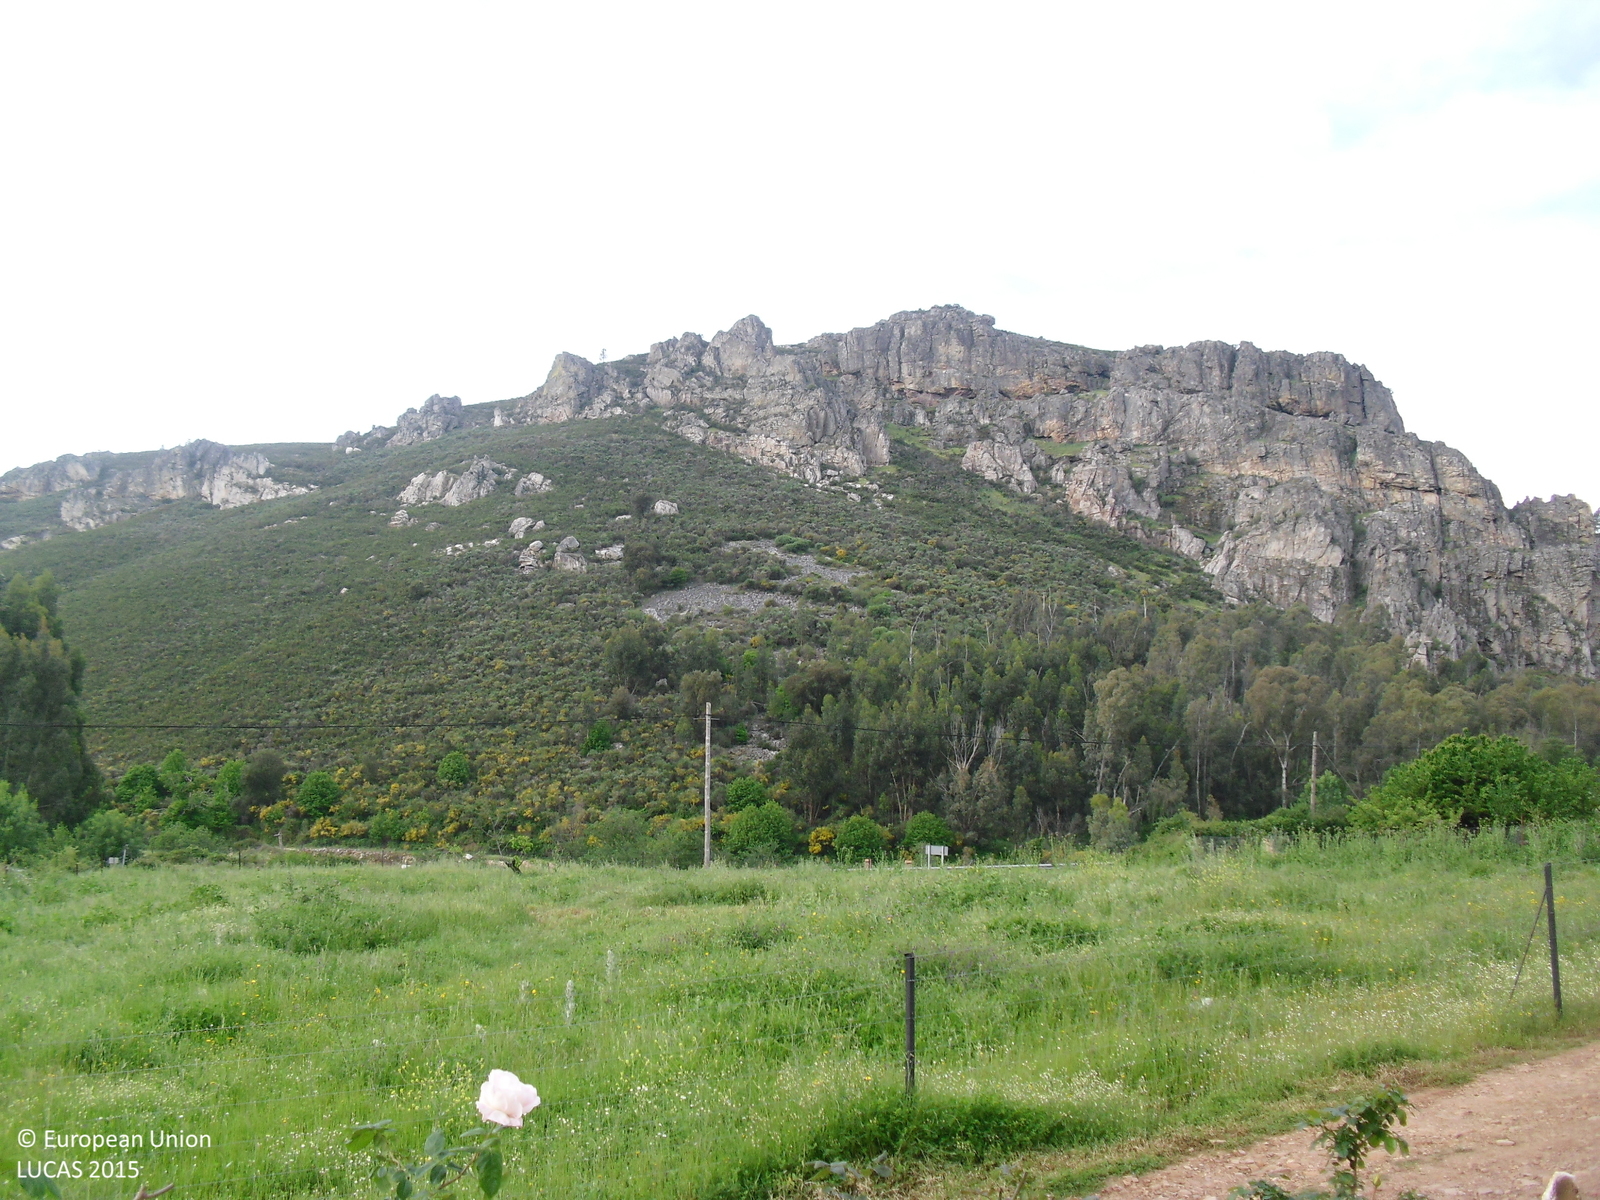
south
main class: Woodland
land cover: Broadleaved woodland
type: thermophilous deciduous forest
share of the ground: 10 - 25 %
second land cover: Grassland without tree/shrub cover
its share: > 75 %
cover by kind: herbaceous plants 80 %, broadleaved forest trees 15 %, shrubs 5 %
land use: Forestry
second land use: Agriculture (excluding fallow land and kitchen gardens)
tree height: > 5 m
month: May
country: ES
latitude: 39.4160
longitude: -5.3685
